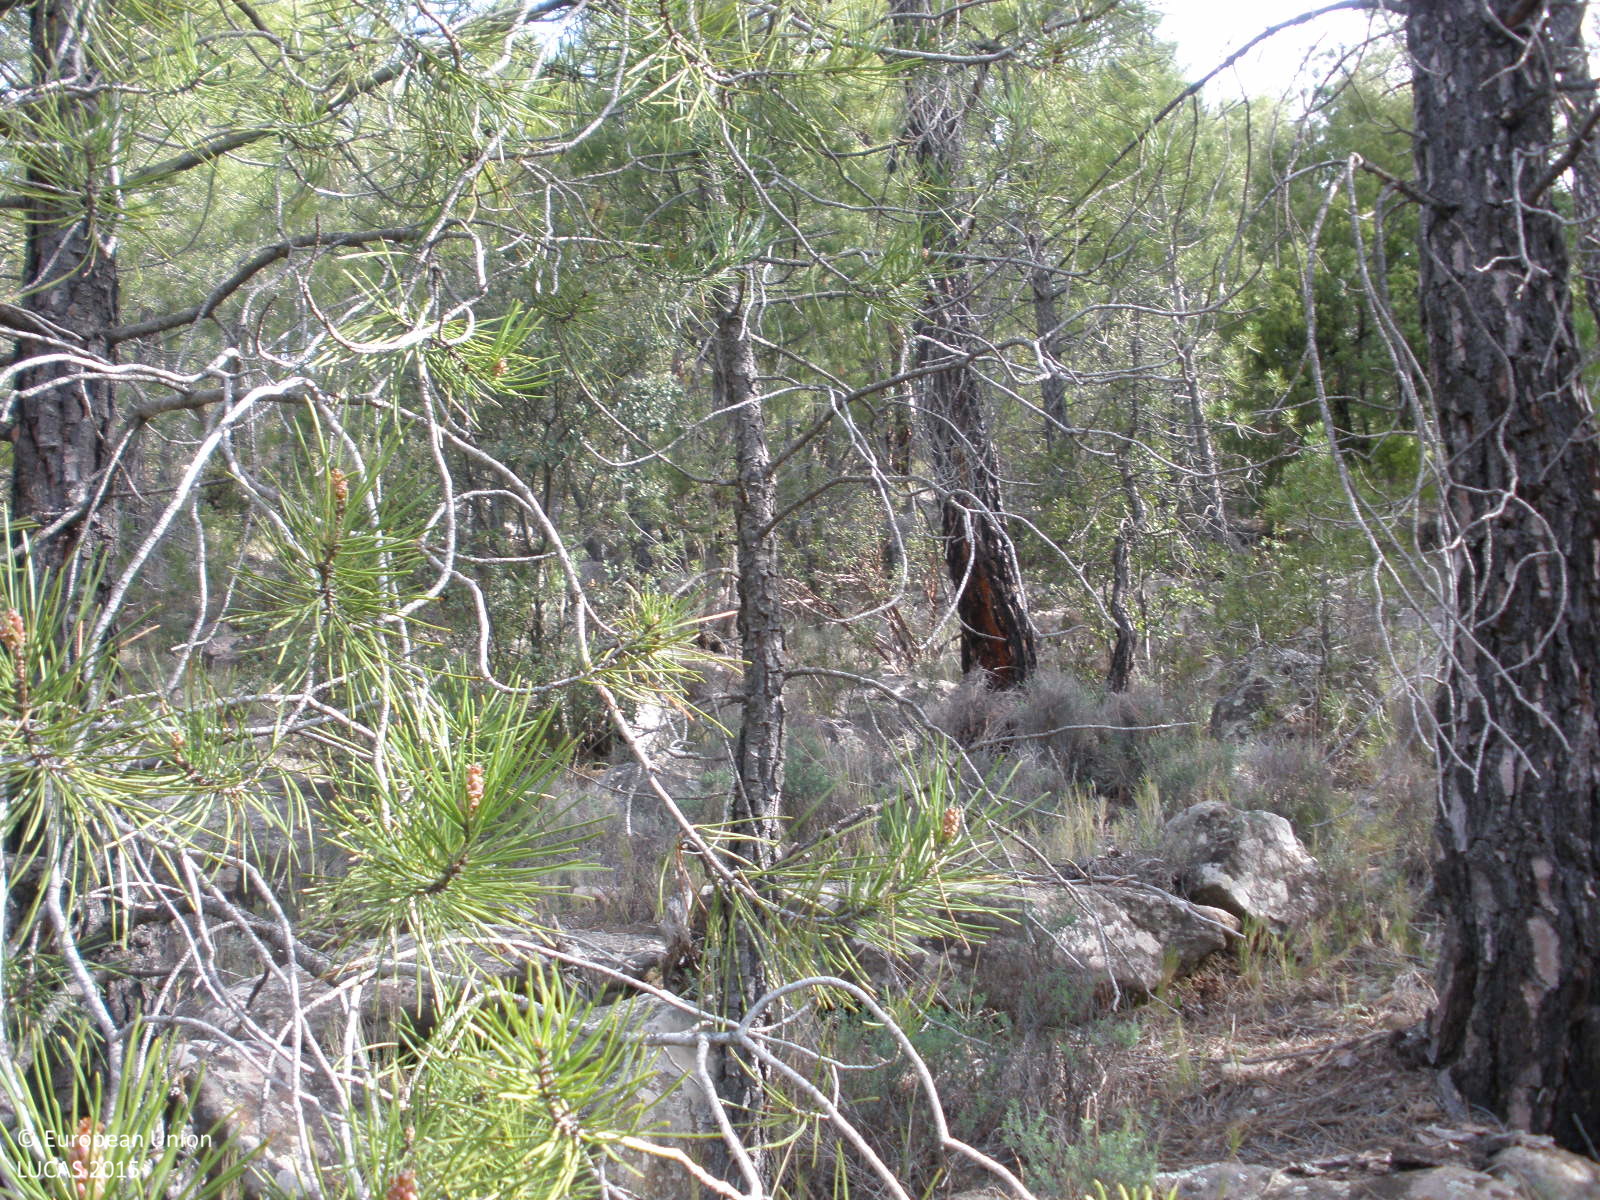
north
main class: Woodland
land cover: Pine dominated coniferous woodland
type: coniferous forest of the mediterranean region
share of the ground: > 75 %
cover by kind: coniferous forest trees 75 %, shrubs 20 %, consolidated bare surface 5 %
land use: Semi-natural and natural areas not in use
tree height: > 5 m
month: April
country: ES
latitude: 40.3616
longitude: -0.8070
